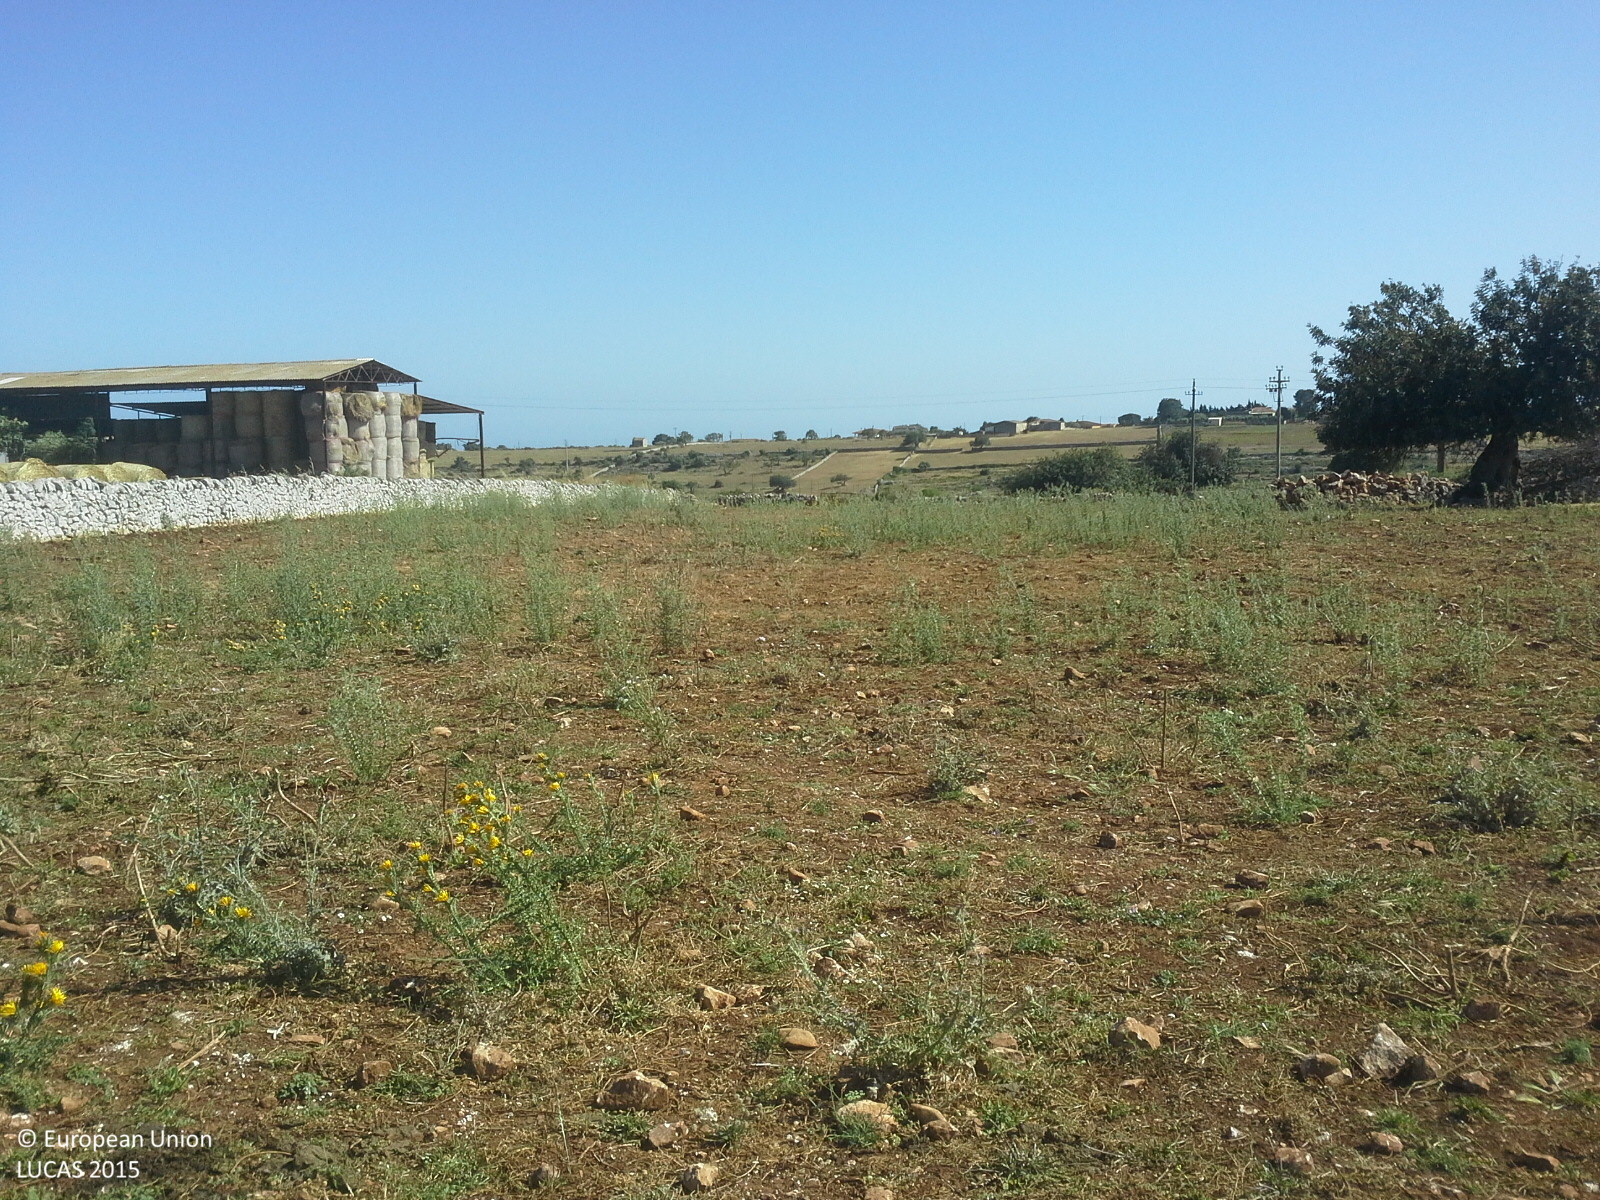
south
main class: Cropland
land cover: Mixed cereals for fodder
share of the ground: > 75 %
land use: Agriculture (excluding fallow land and kitchen gardens)
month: May
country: IT
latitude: 36.8058
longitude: 14.8368
